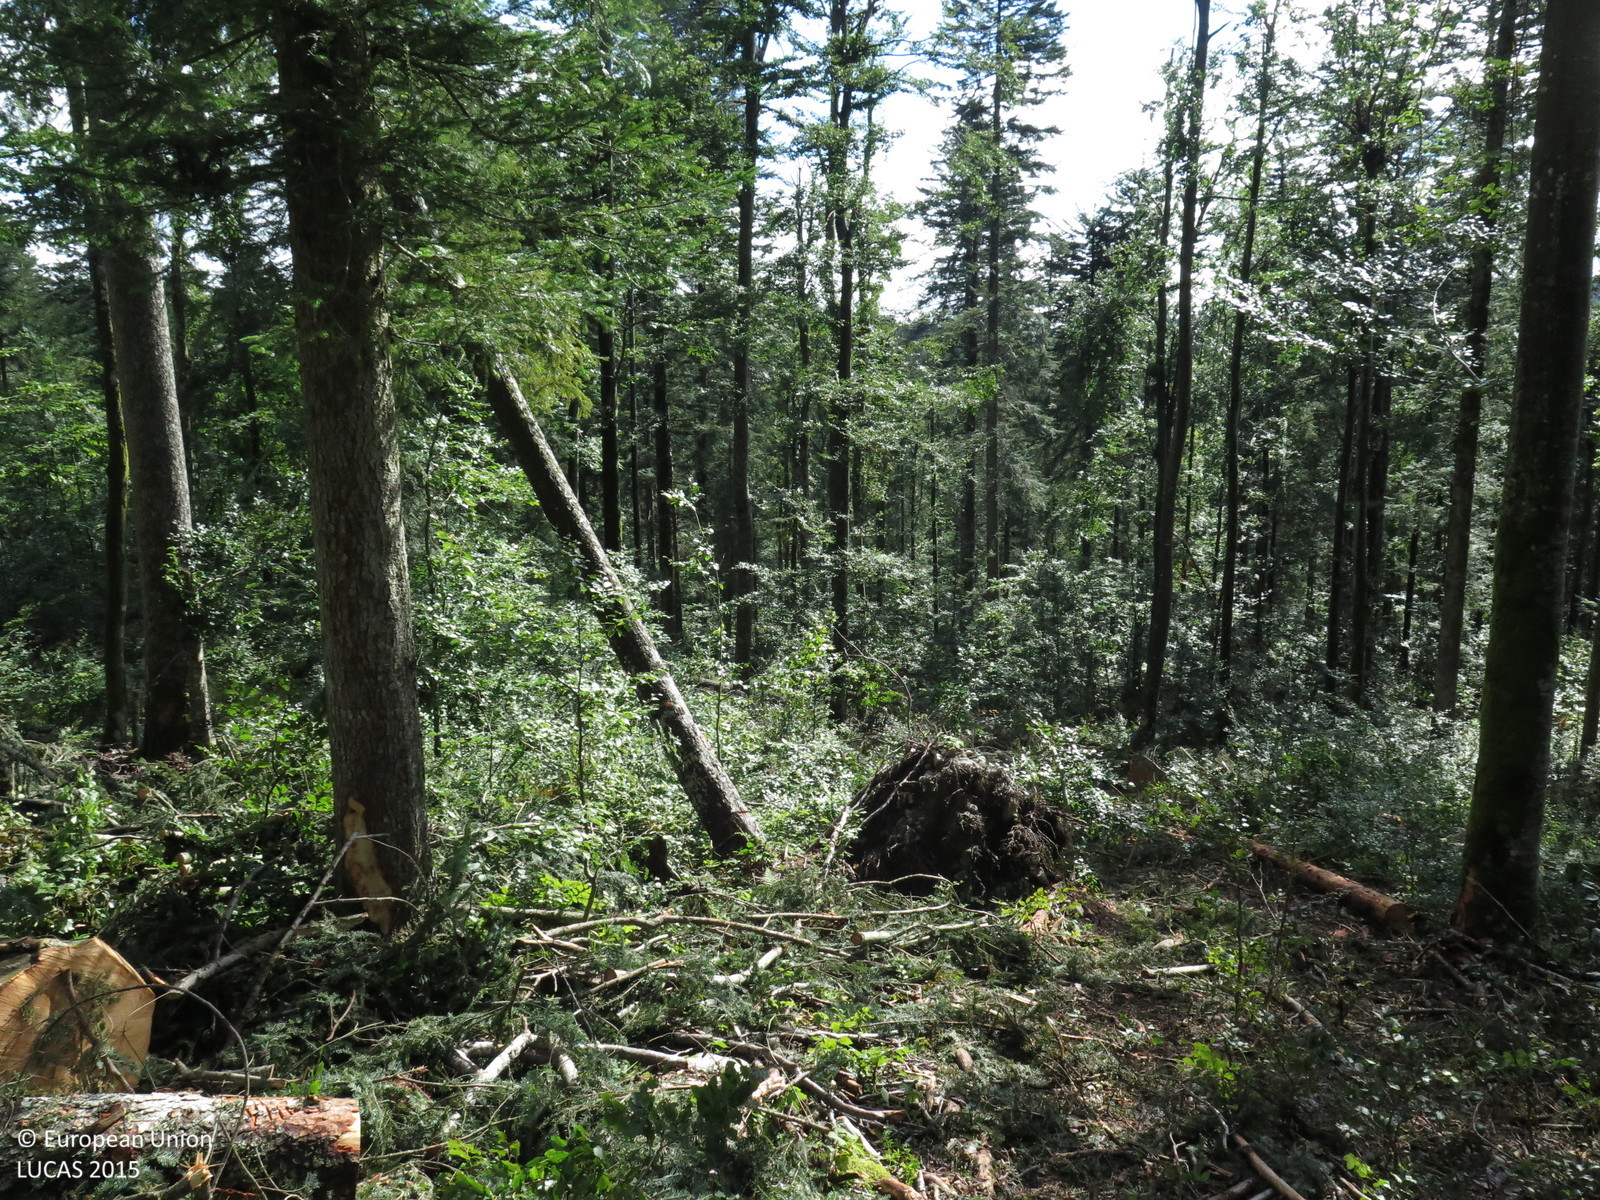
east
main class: Woodland
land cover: Other mixed woodland
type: mountainous beech forest
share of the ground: > 75 %
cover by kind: broadleaved forest trees 75 %, coniferous forest trees 25 %
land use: Forestry
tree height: > 5 m
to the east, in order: Other mixed woodland
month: September
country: HR
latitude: 45.4758
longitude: 14.6133
